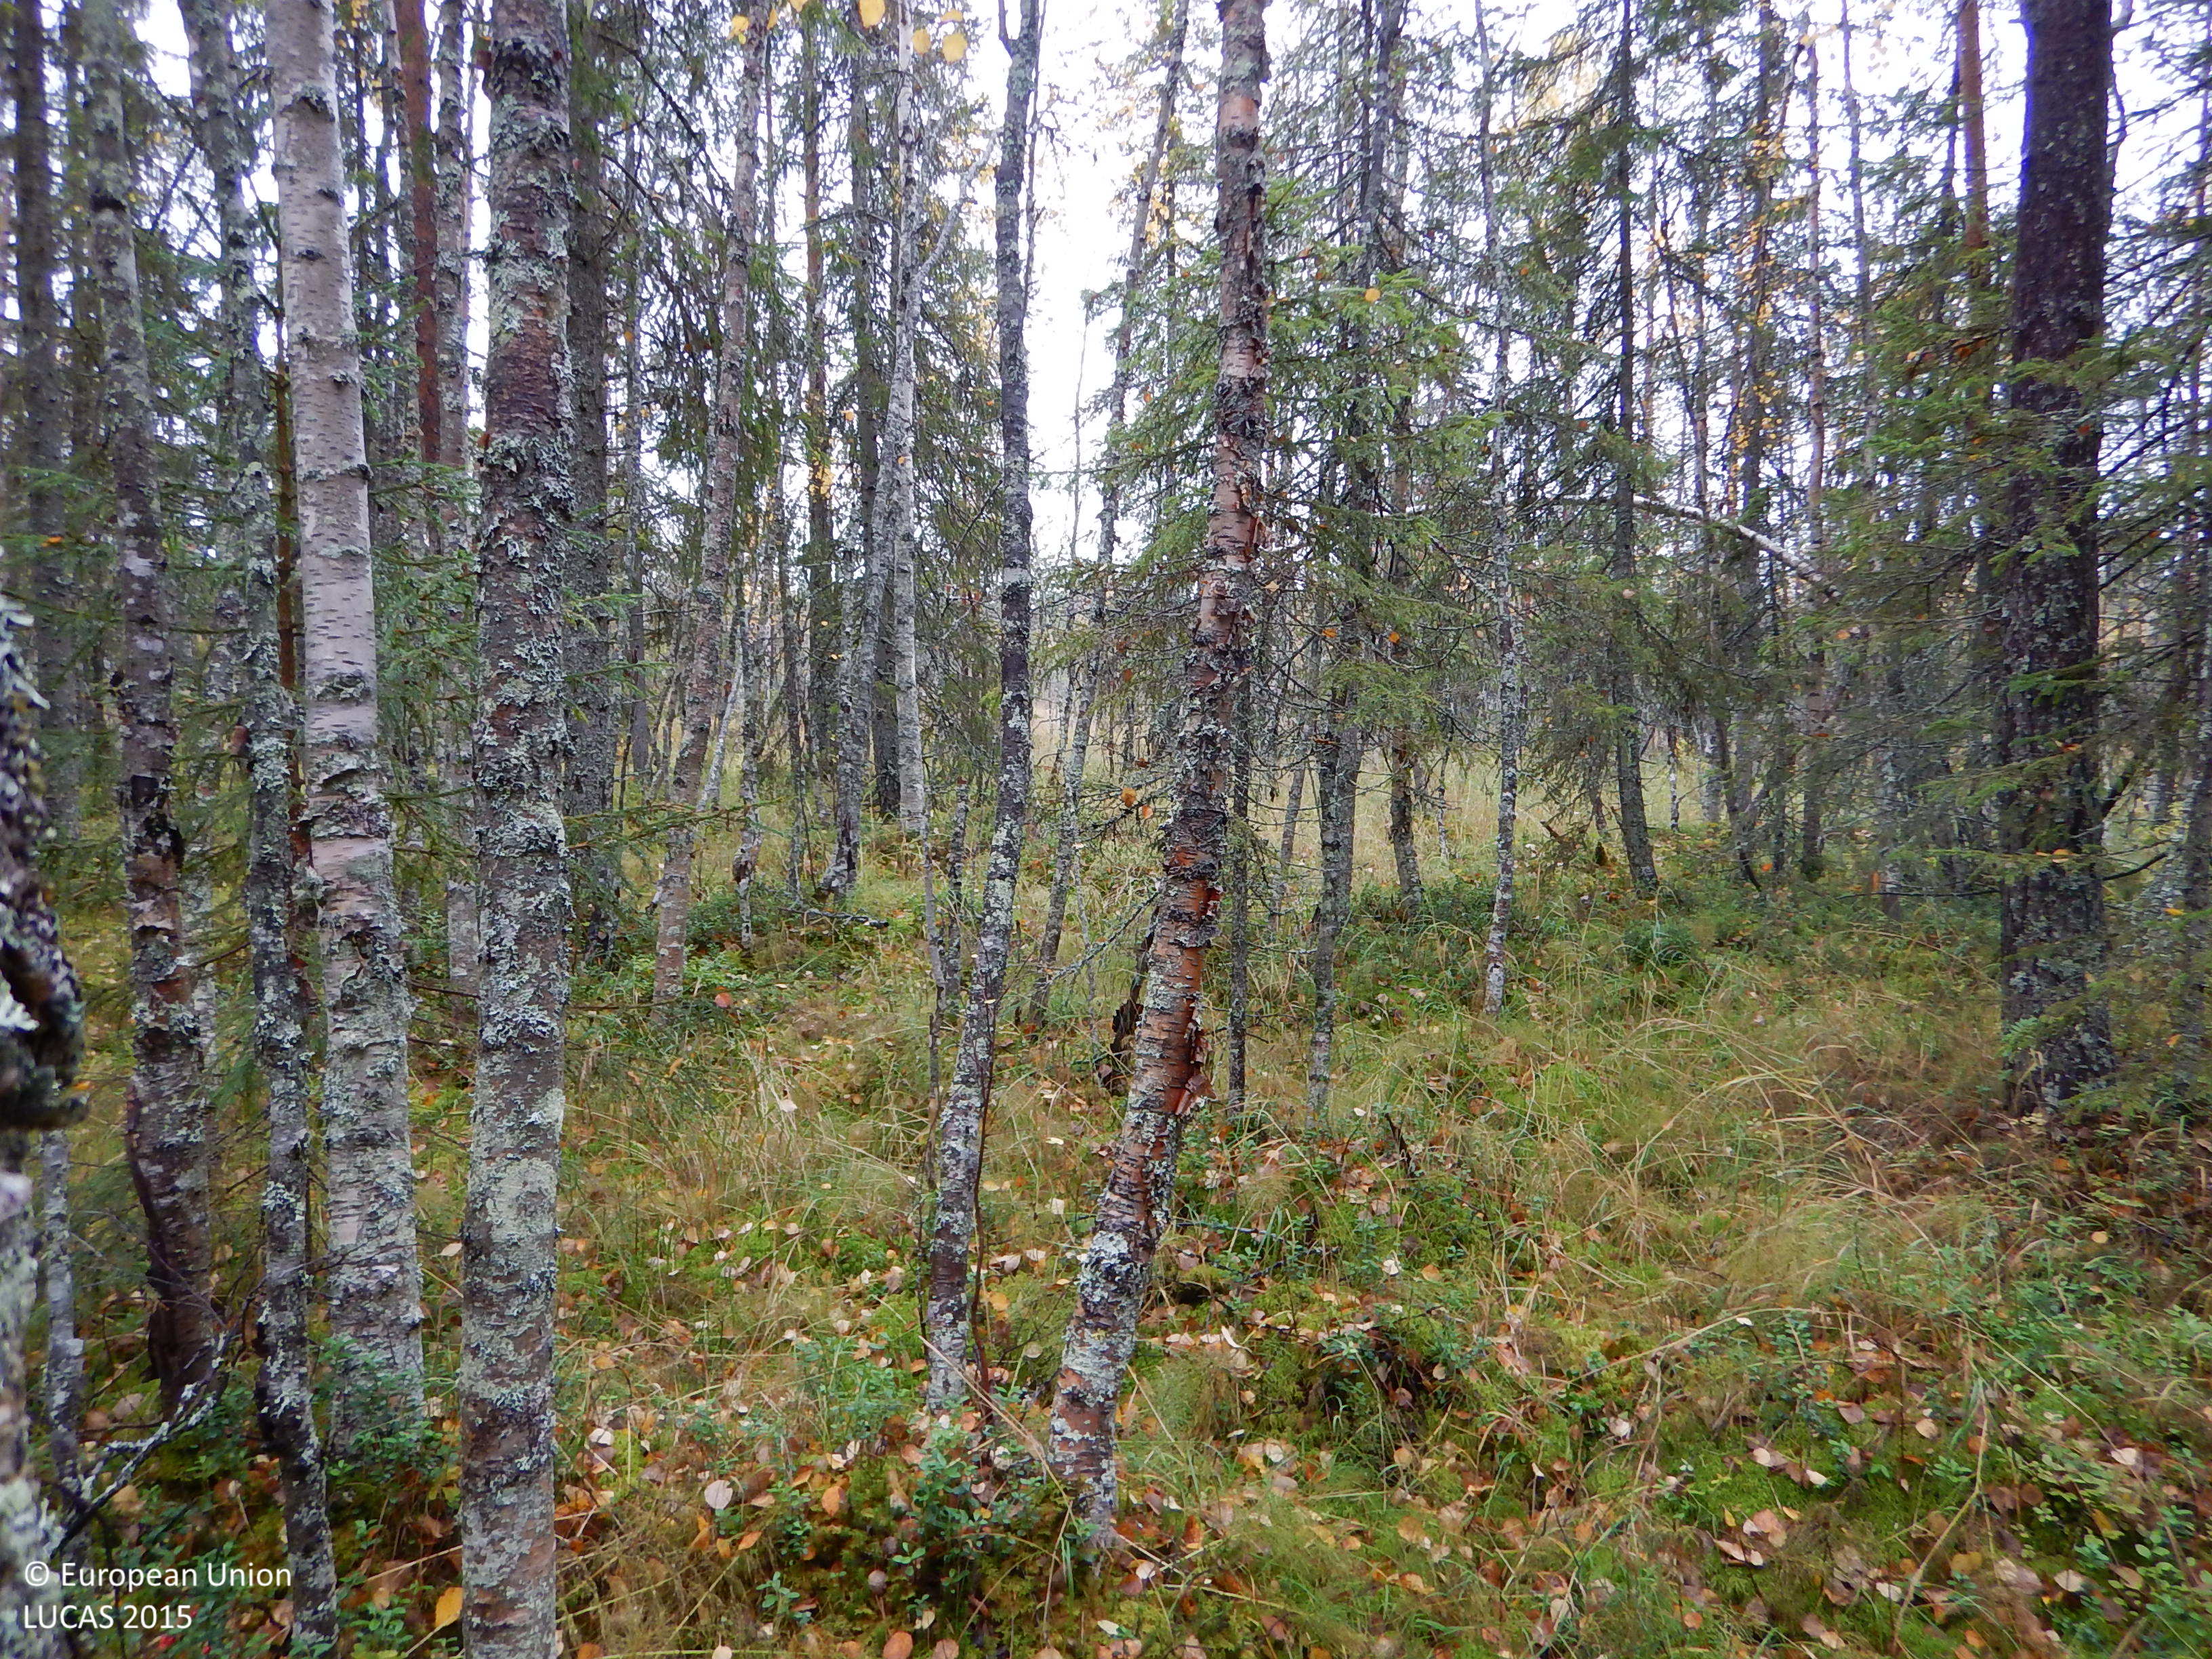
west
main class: Woodland
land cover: Other mixed woodland
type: mire and swamp forests
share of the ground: 50 - 75 %
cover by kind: coniferous forest trees 30 %, broadleaved forest trees 30 %, lichens and mosses 20 %, shrubs 10 %, herbaceous plants 10 %
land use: Amenities, museums, leisure
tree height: > 5 m
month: September
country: SE
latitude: 65.0881
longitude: 19.9470
